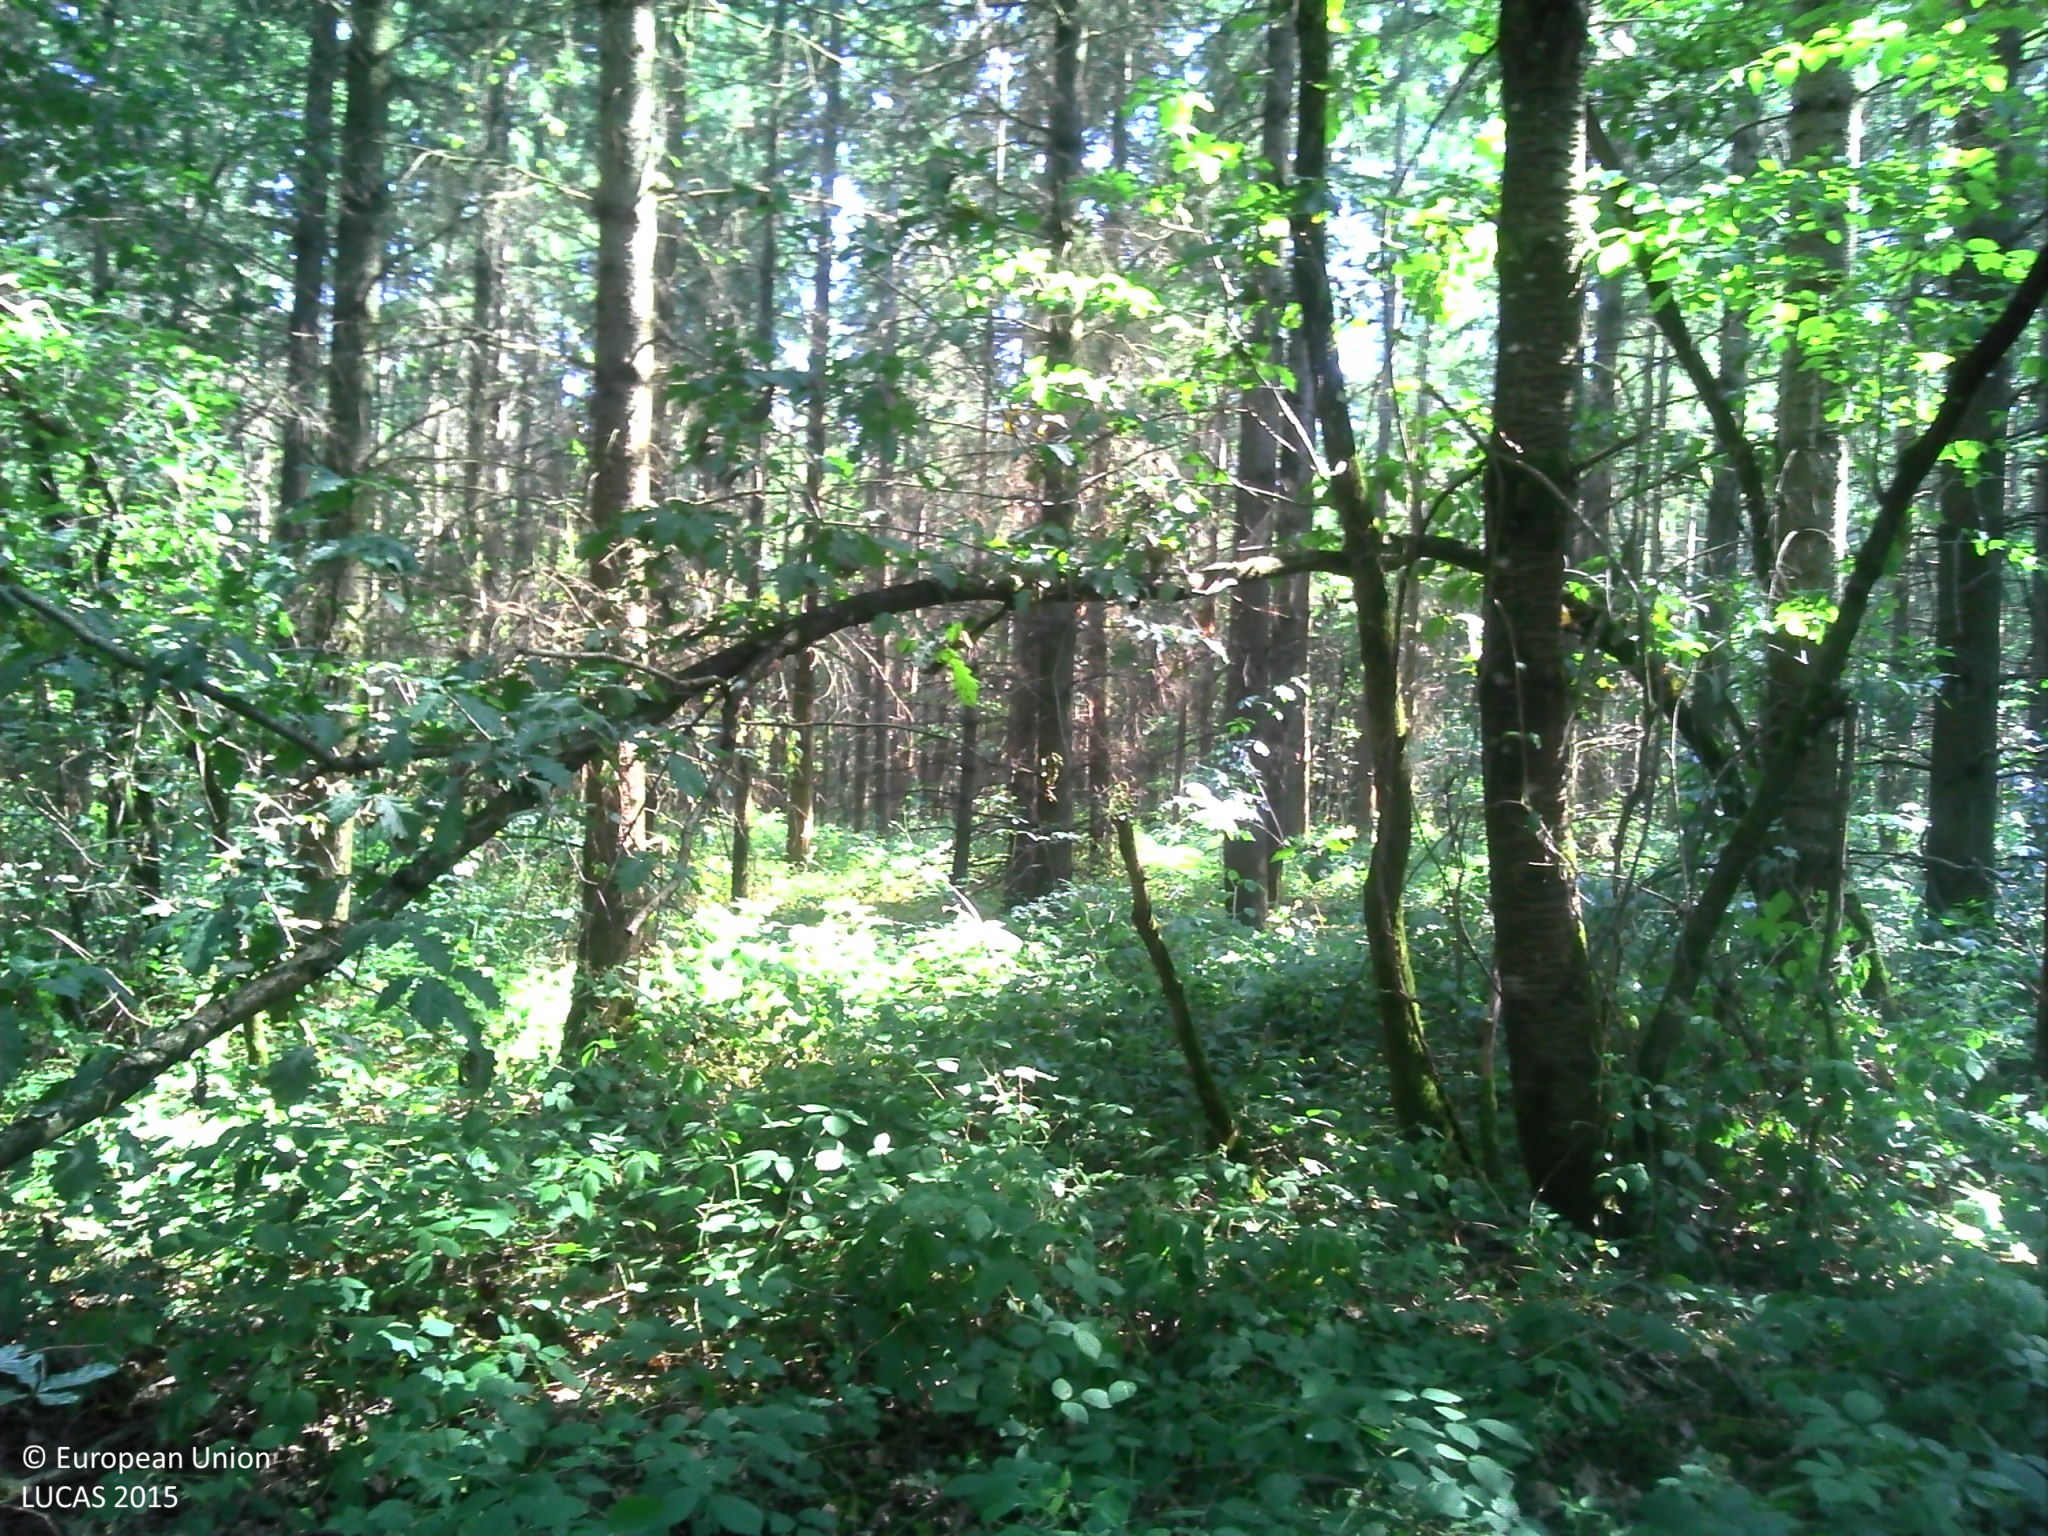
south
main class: Woodland
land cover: Other mixed woodland
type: exotic forest
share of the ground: > 75 %
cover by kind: broadleaved forest trees 75 %, coniferous forest trees 25 %
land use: Forestry
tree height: > 5 m
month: July
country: FR
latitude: 46.2538
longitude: 3.0842
